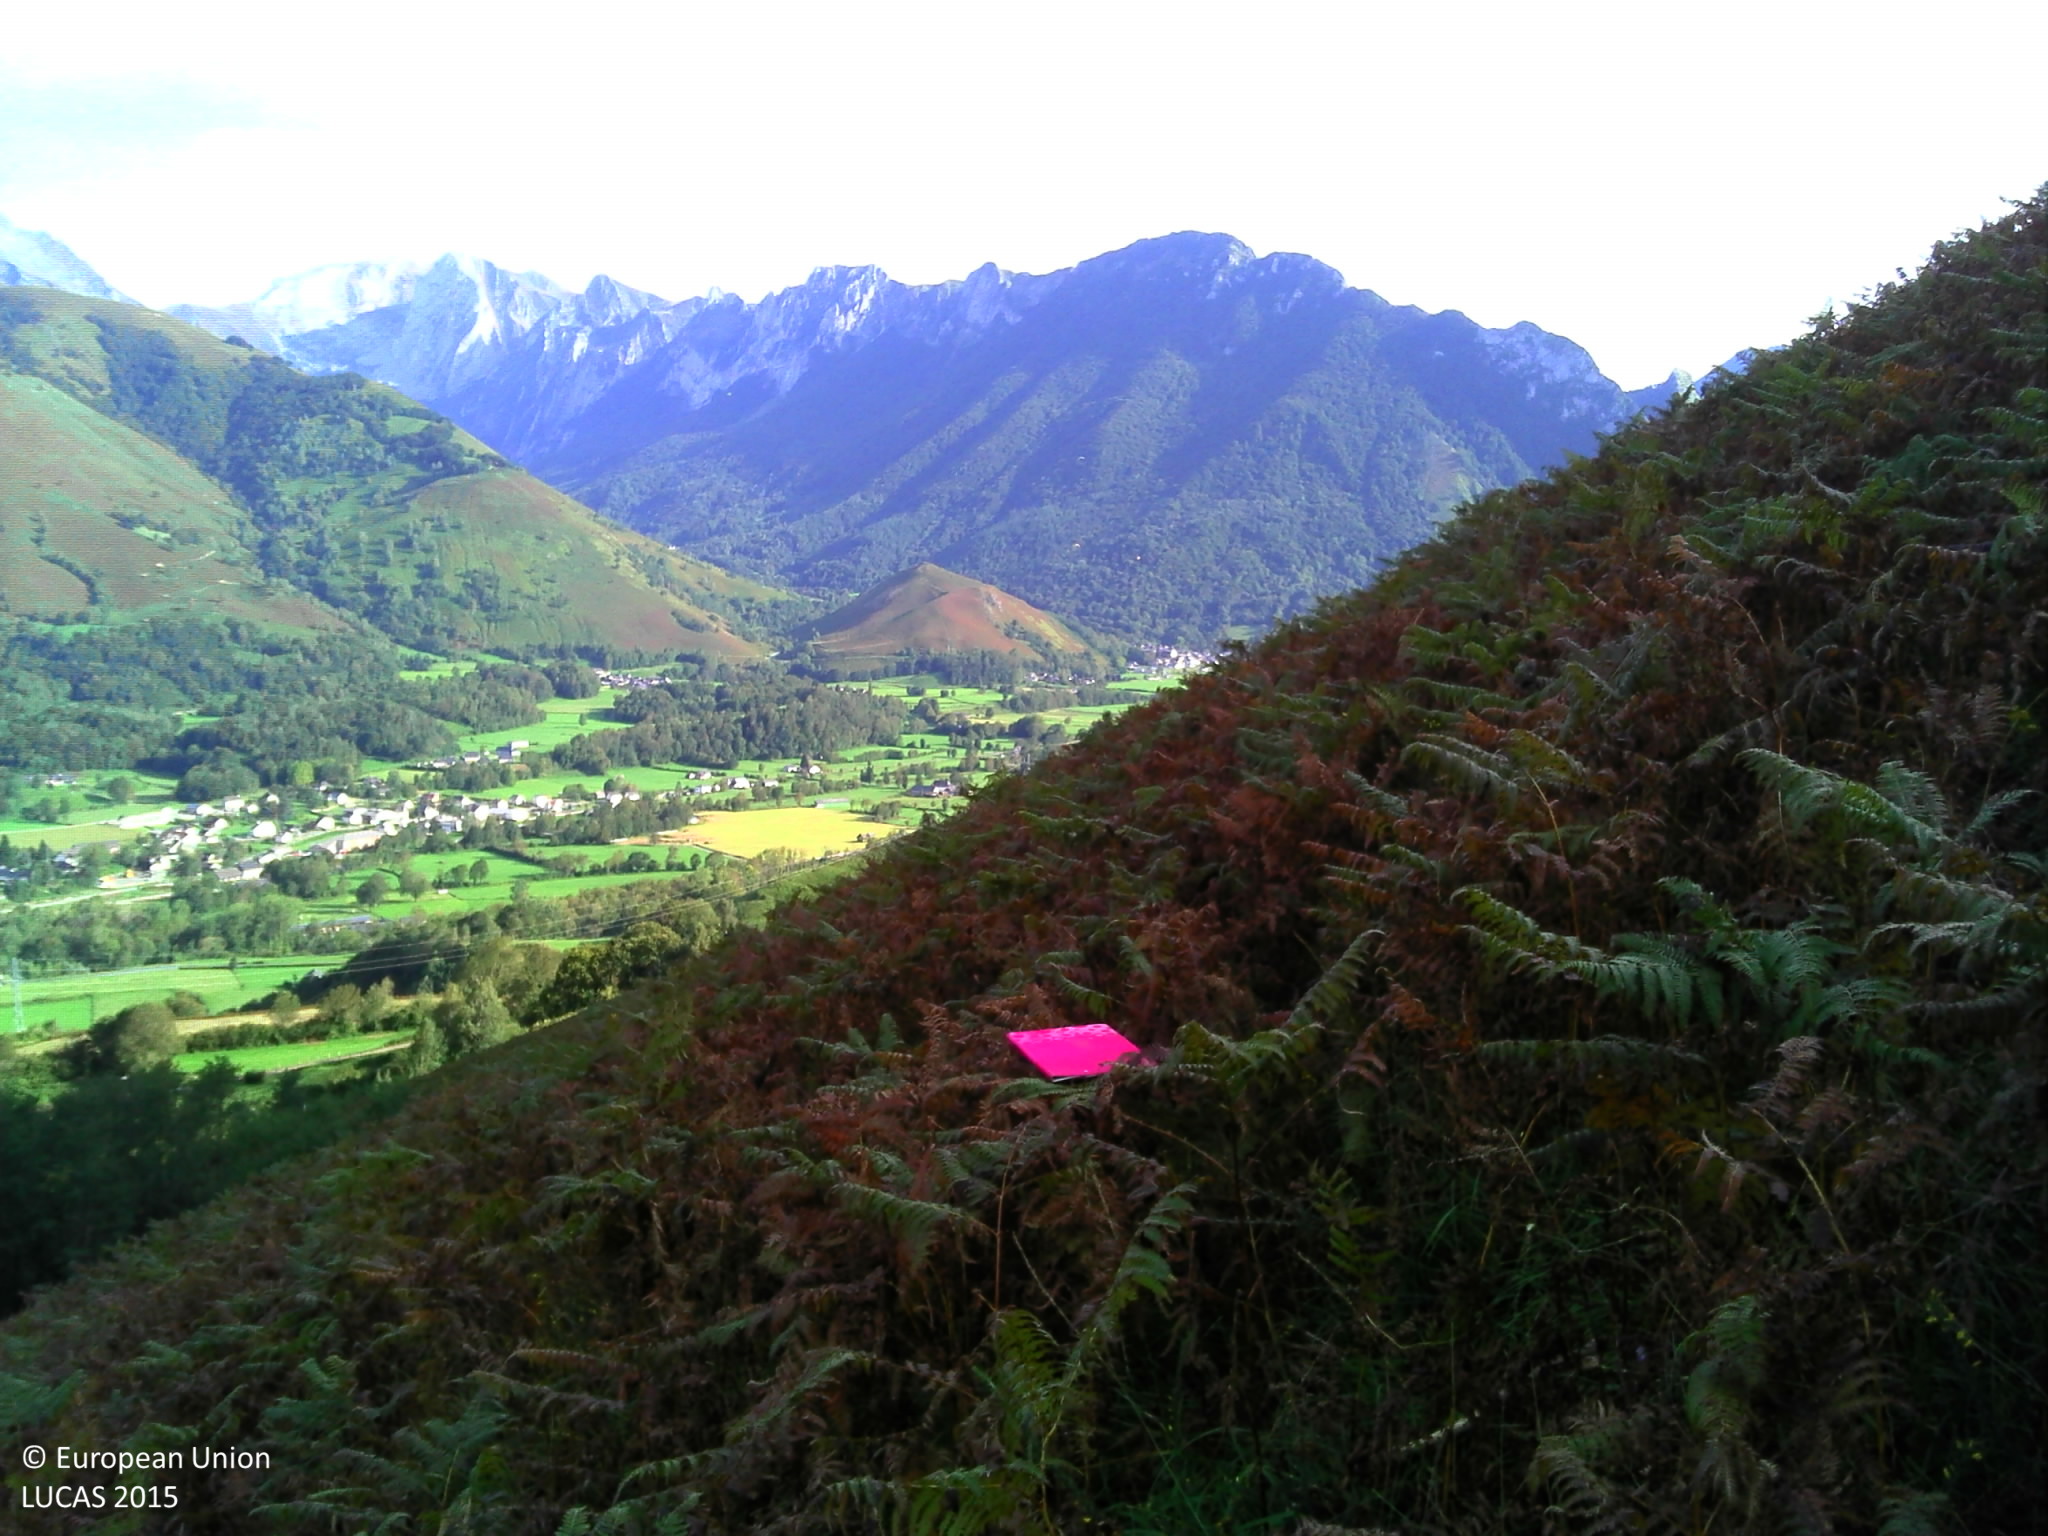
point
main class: Grassland
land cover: Grassland without tree/shrub cover
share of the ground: > 75 %
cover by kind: herbaceous plants 95 %, shrubs 5 %
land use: Agriculture (excluding fallow land and kitchen gardens)
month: September
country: FR
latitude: 43.0041
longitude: -0.6181
